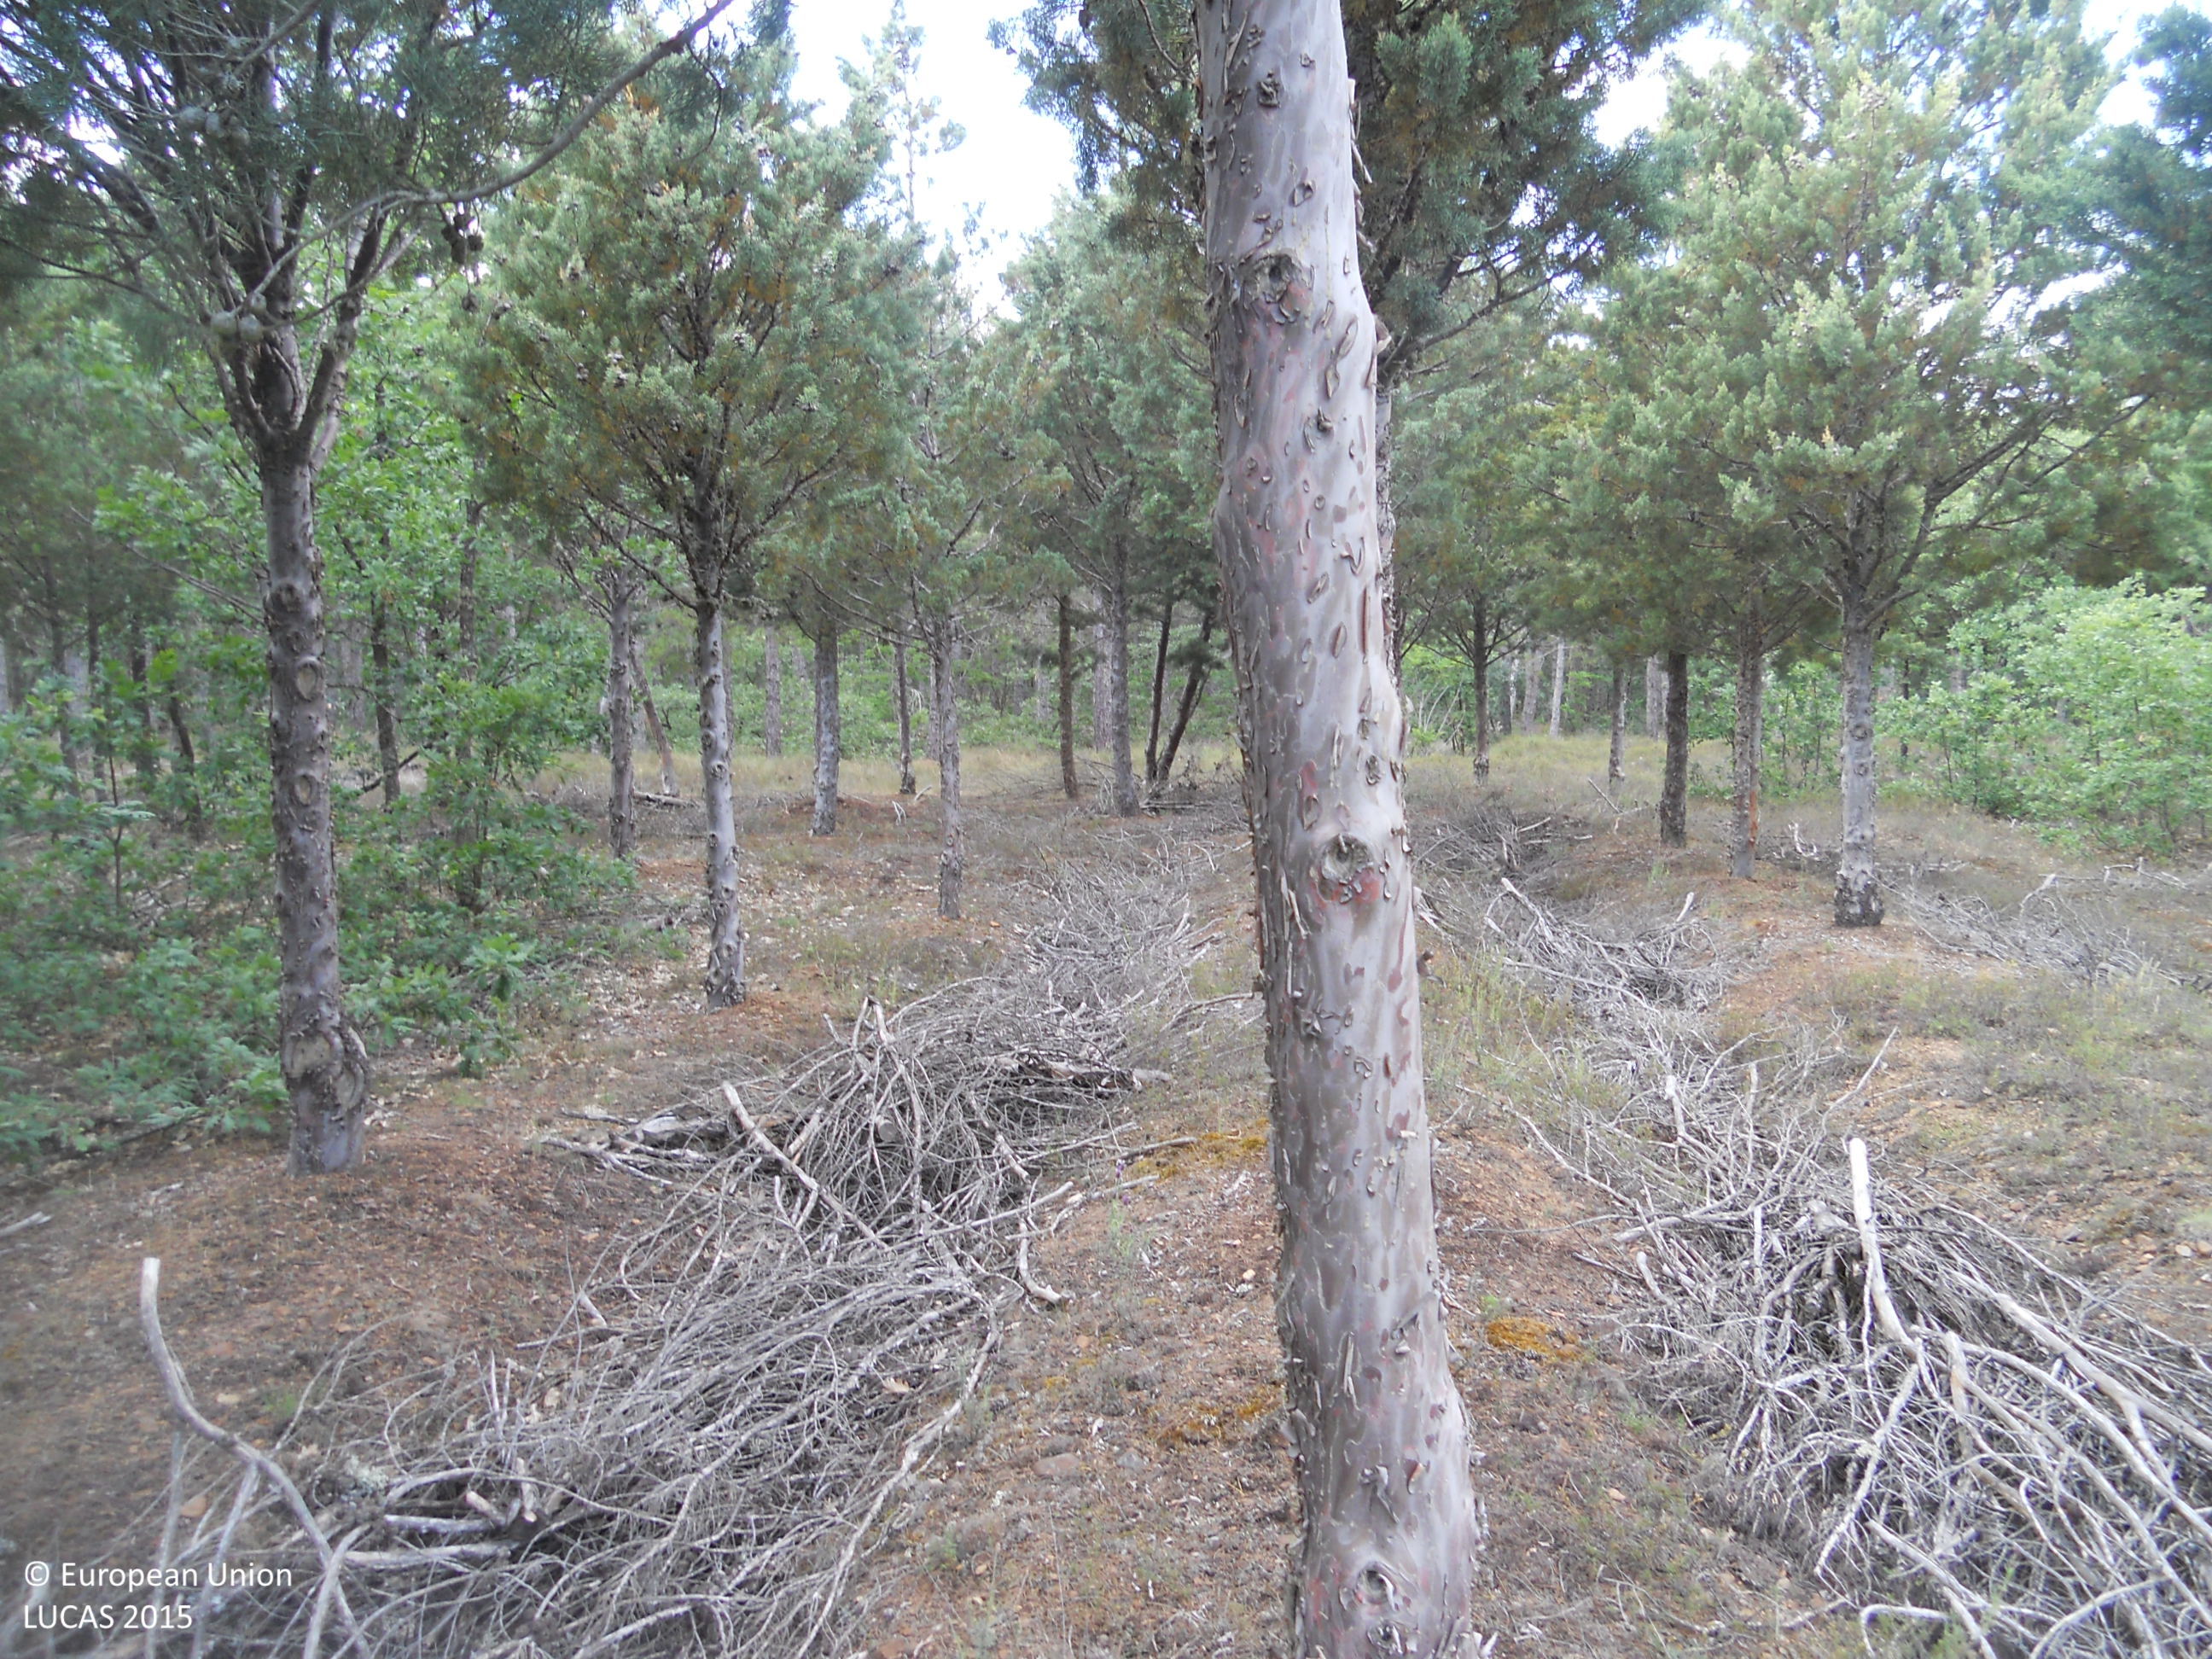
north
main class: Woodland
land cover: Other mixed woodland
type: acidophilous oak and oak-birch forest
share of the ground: > 75 %
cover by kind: broadleaved forest trees 35 %, herbaceous plants 20 %, coniferous forest trees 15 %, shrubs 5 %, unconsolidated bare surface 5 %
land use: Forestry
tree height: < 5 m
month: June
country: ES
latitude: 42.3616
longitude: -4.8320
